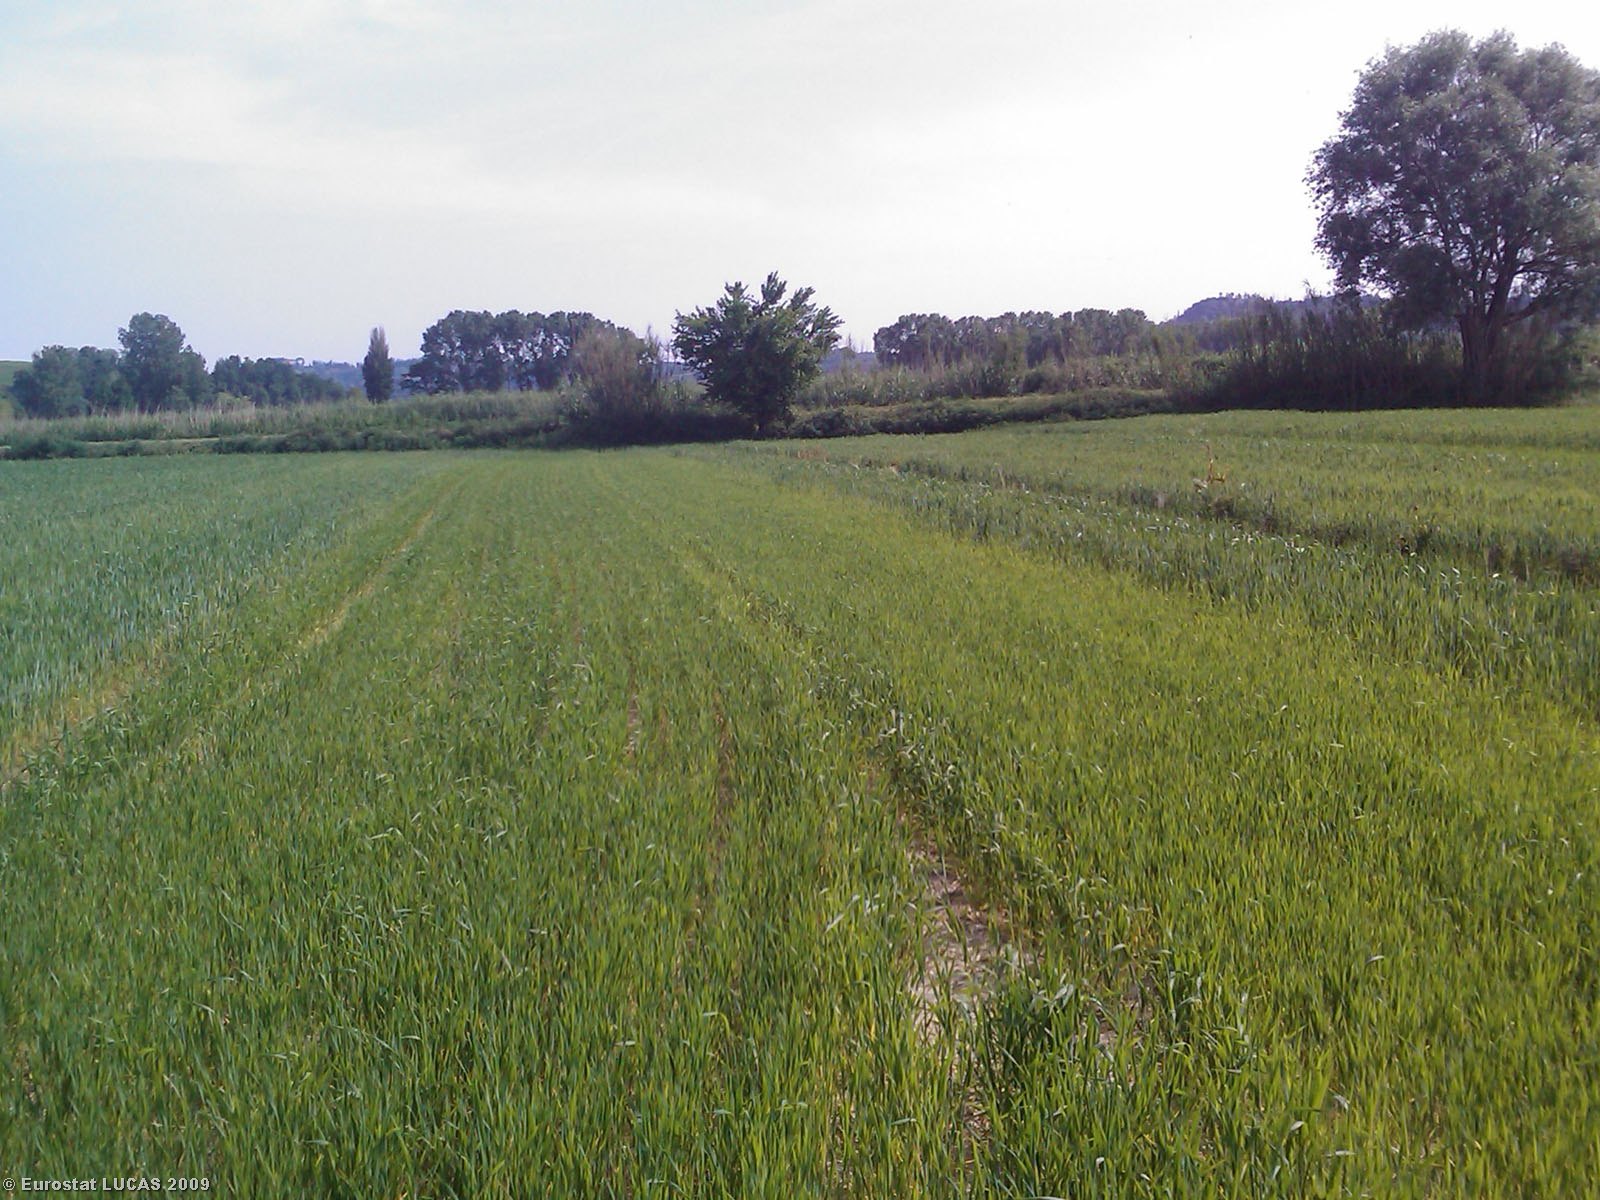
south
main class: Cropland
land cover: Common wheat
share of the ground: > 75 %
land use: Agriculture (excluding fallow land and kitchen gardens)
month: May
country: IT
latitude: 43.6799
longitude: 10.8041
